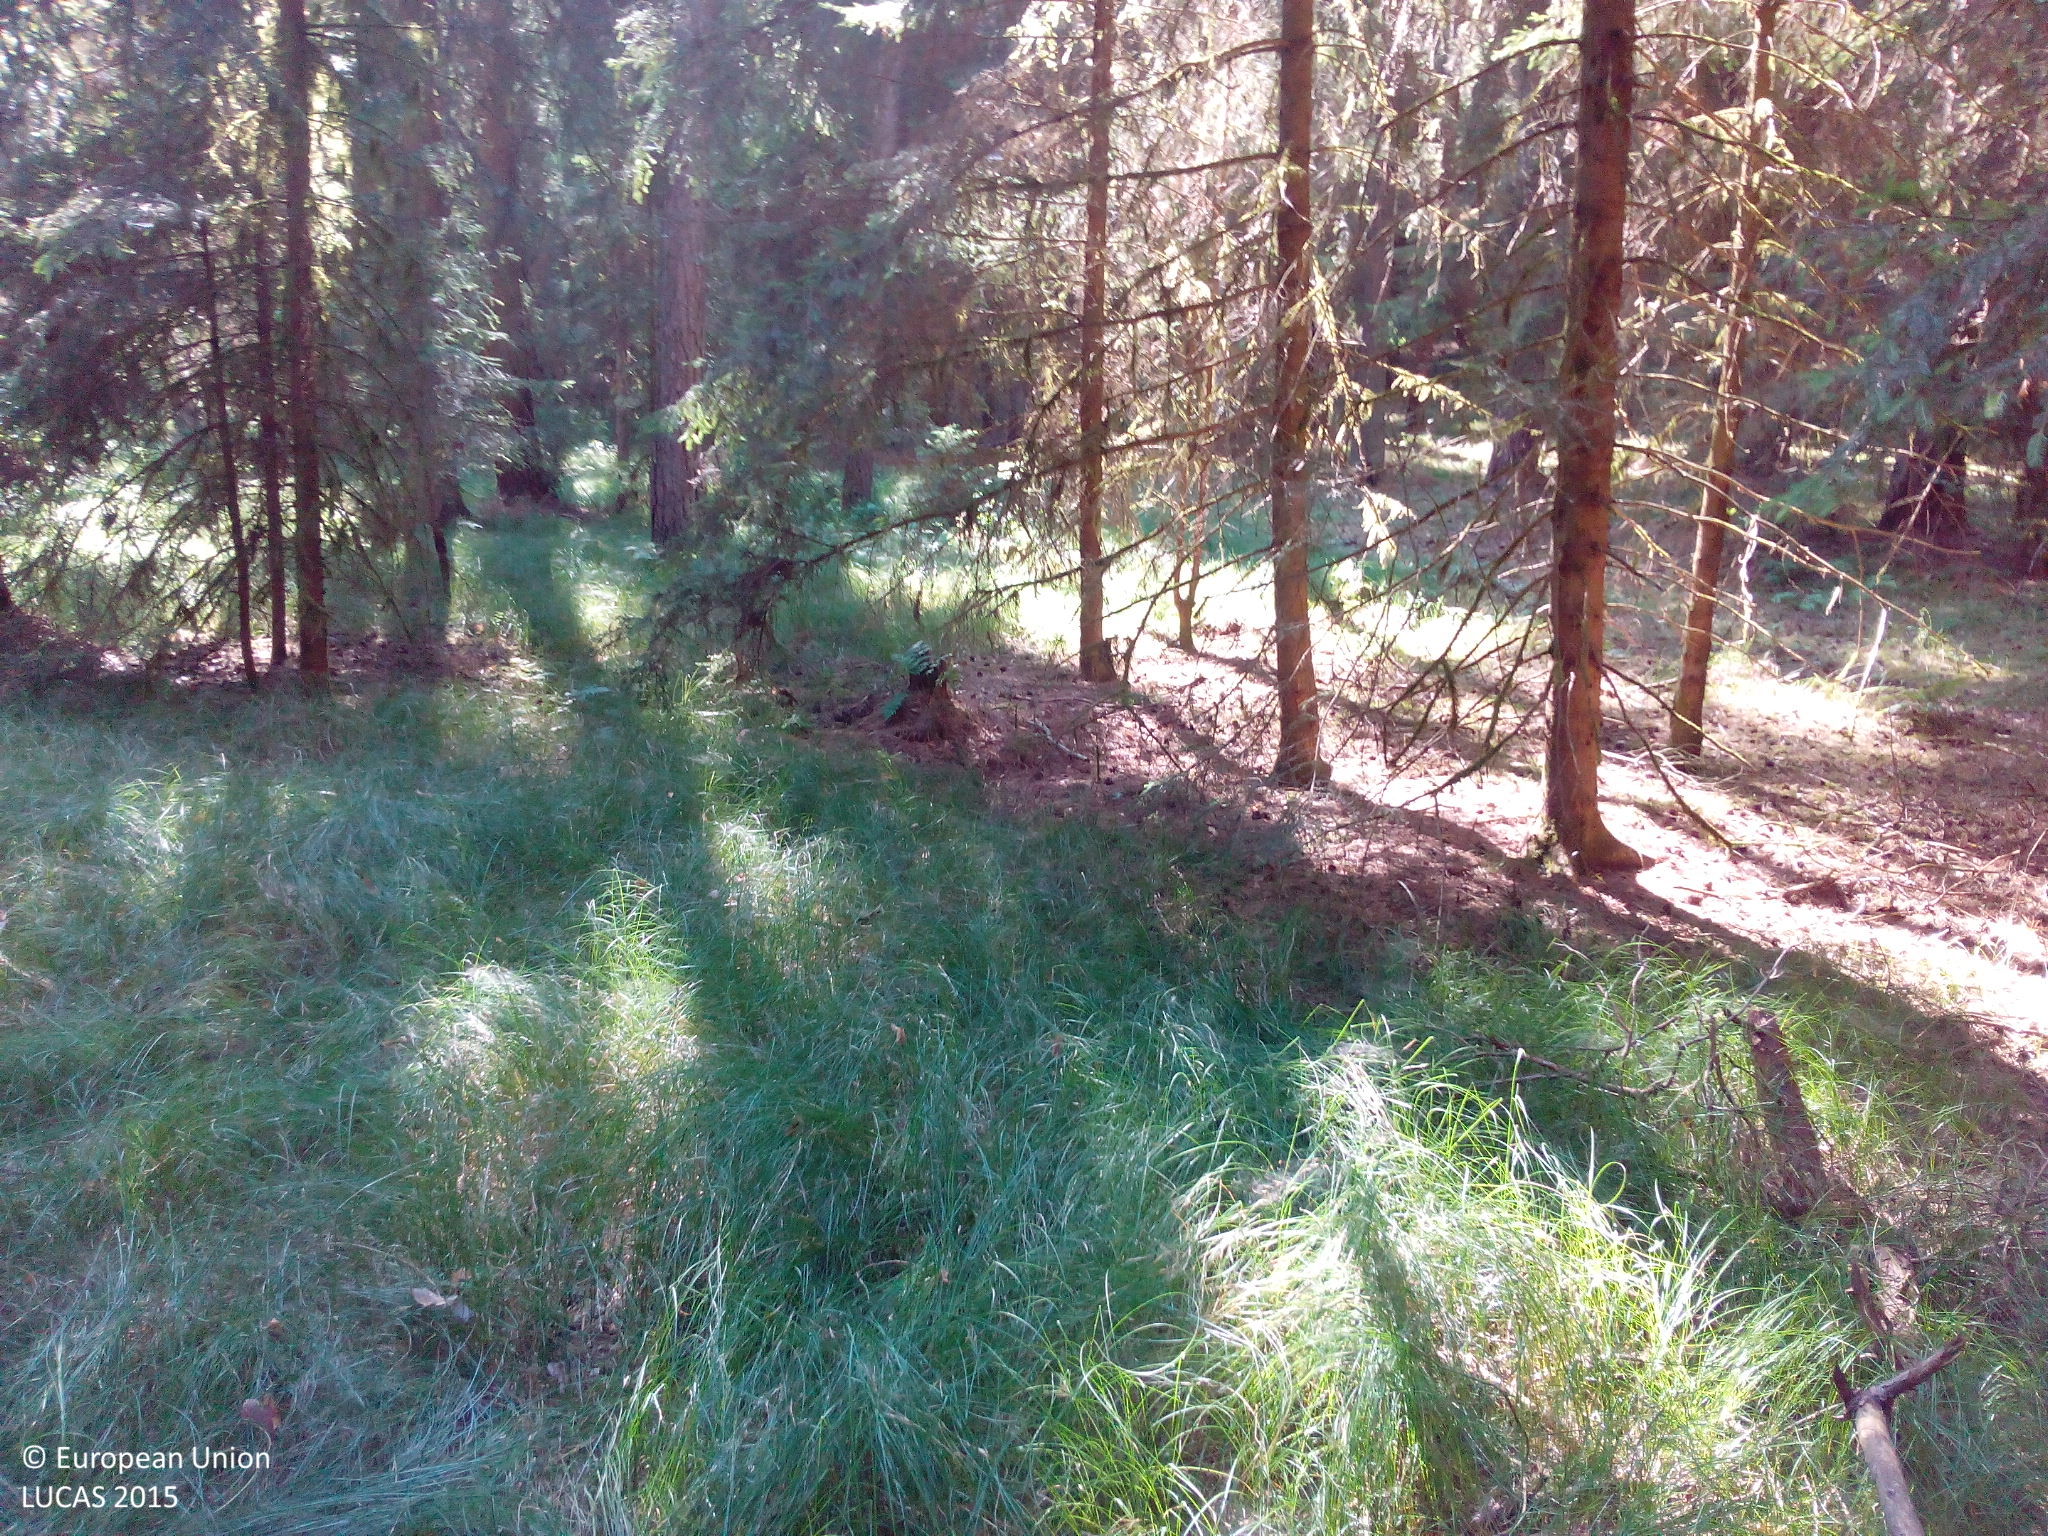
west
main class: Woodland
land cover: Other coniferous woodland
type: hemiboreal forest and nemoral coniferous forest and mixed broadleaved-coniferous forest
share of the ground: > 75 %
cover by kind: coniferous forest trees 85 %, herbaceous plants 10 %, unconsolidated bare surface 5 %
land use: Forestry
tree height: > 5 m
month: July
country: DE
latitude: 49.3534
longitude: 10.8945
